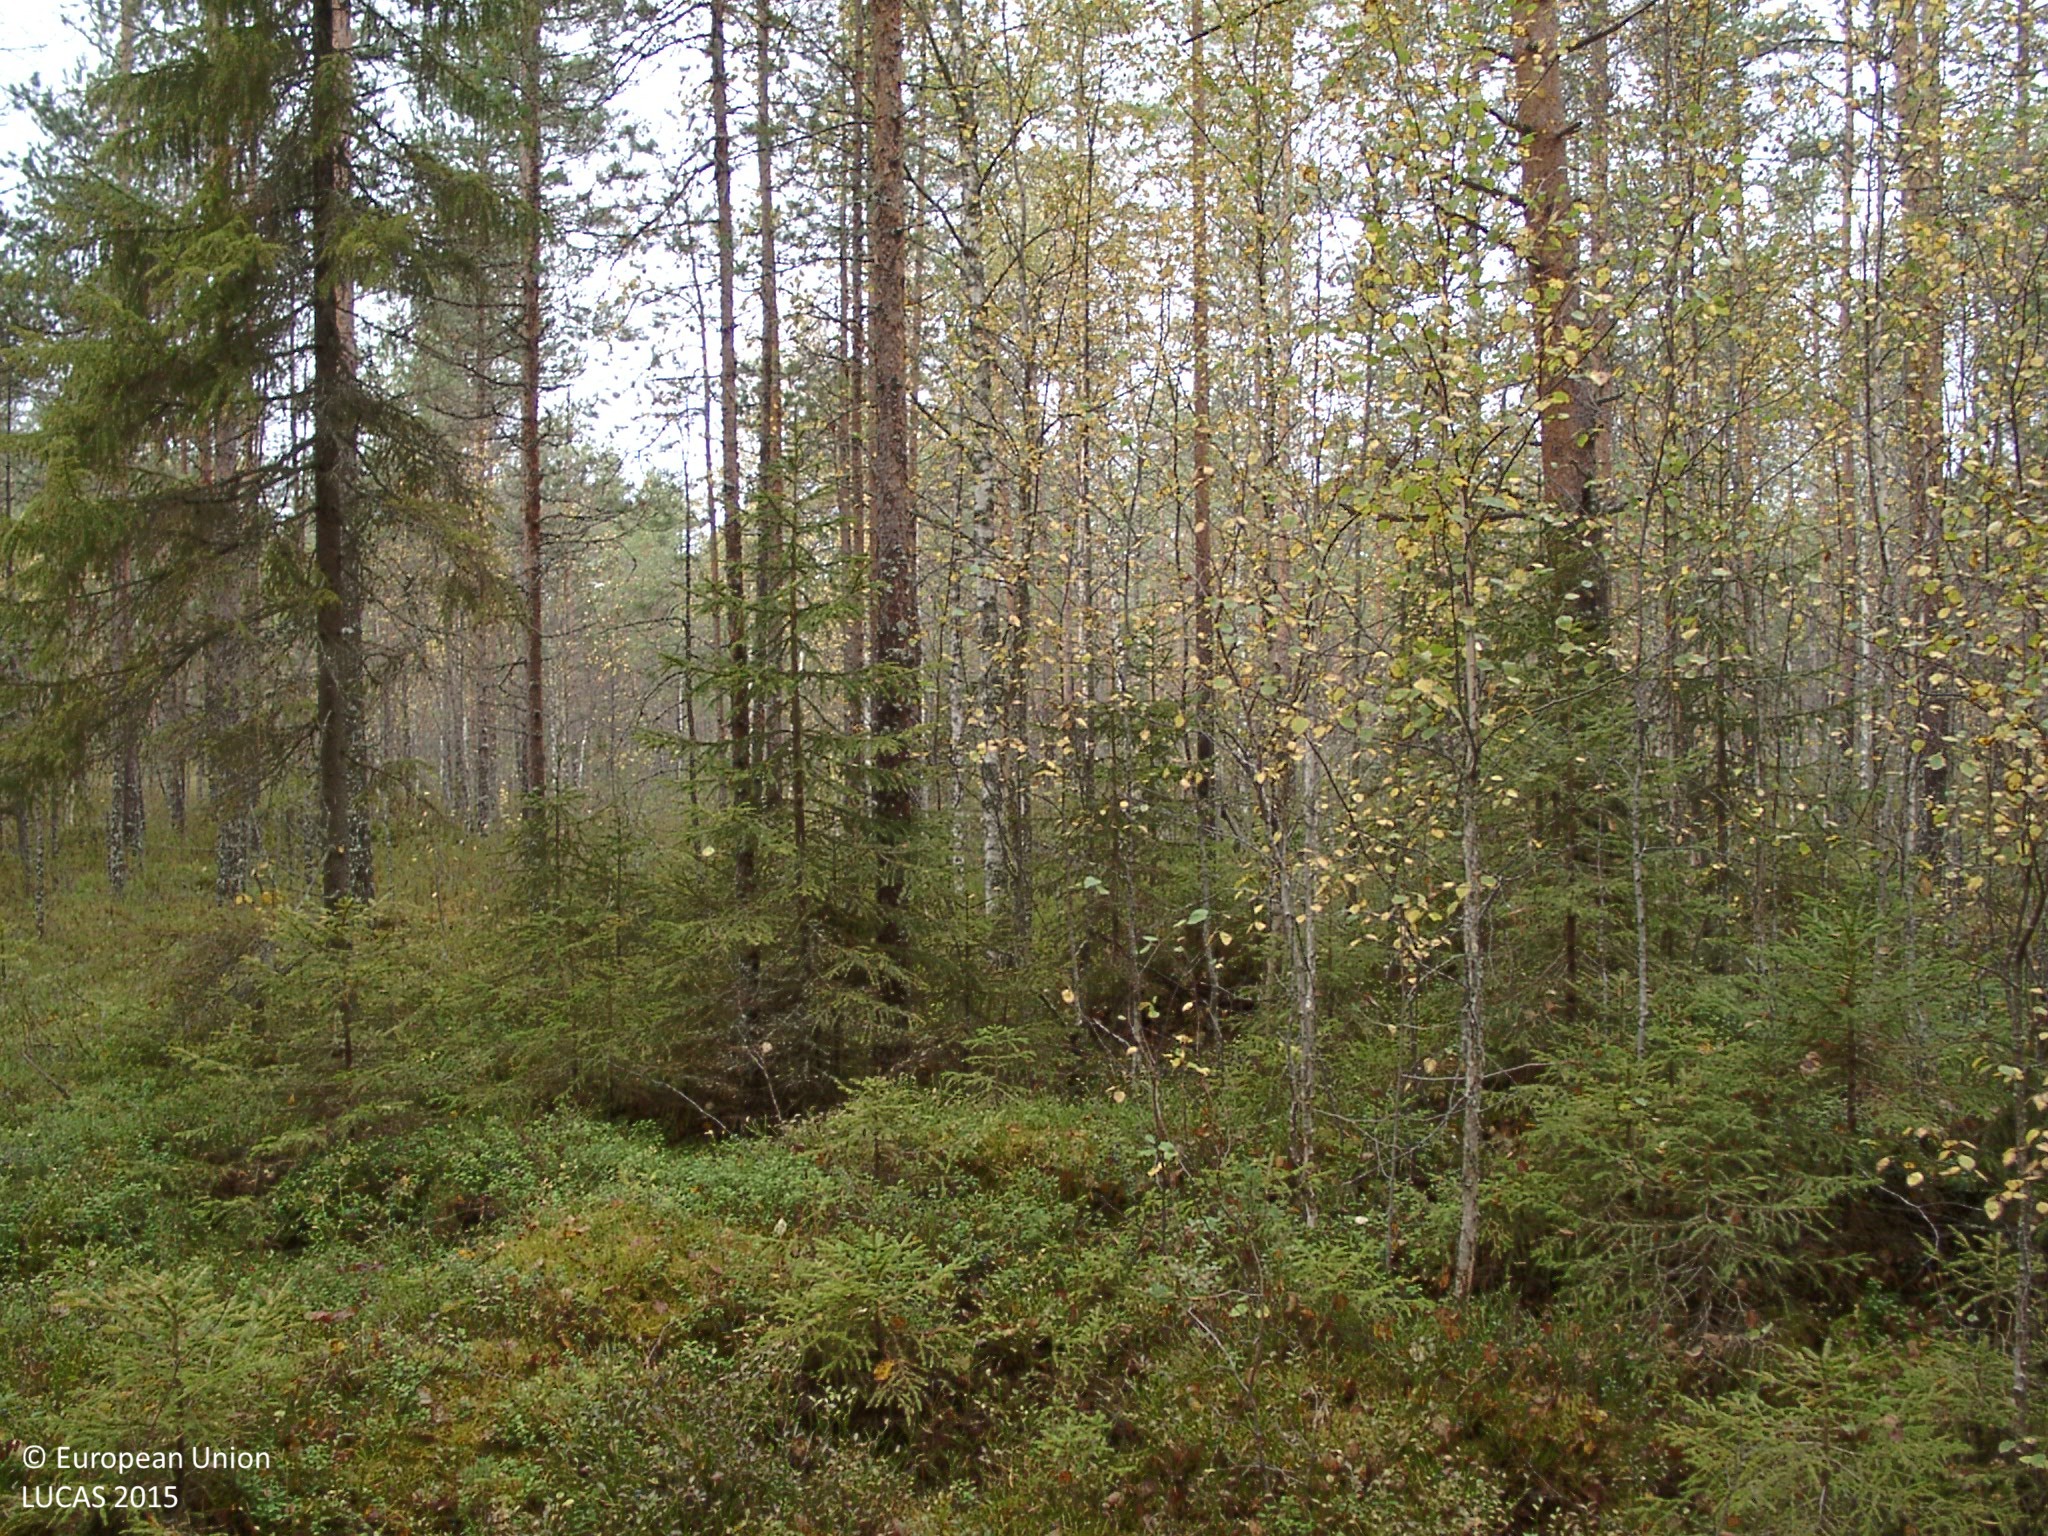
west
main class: Woodland
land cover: Other mixed woodland
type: mire and swamp forests
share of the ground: 50 - 75 %
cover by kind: coniferous forest trees 45 %, shrubs 25 %, broadleaved forest trees 15 %, lichens and mosses 10 %, herbaceous plants 5 %
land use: Forestry
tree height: > 5 m
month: September
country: FI
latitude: 62.5046
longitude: 25.3096
